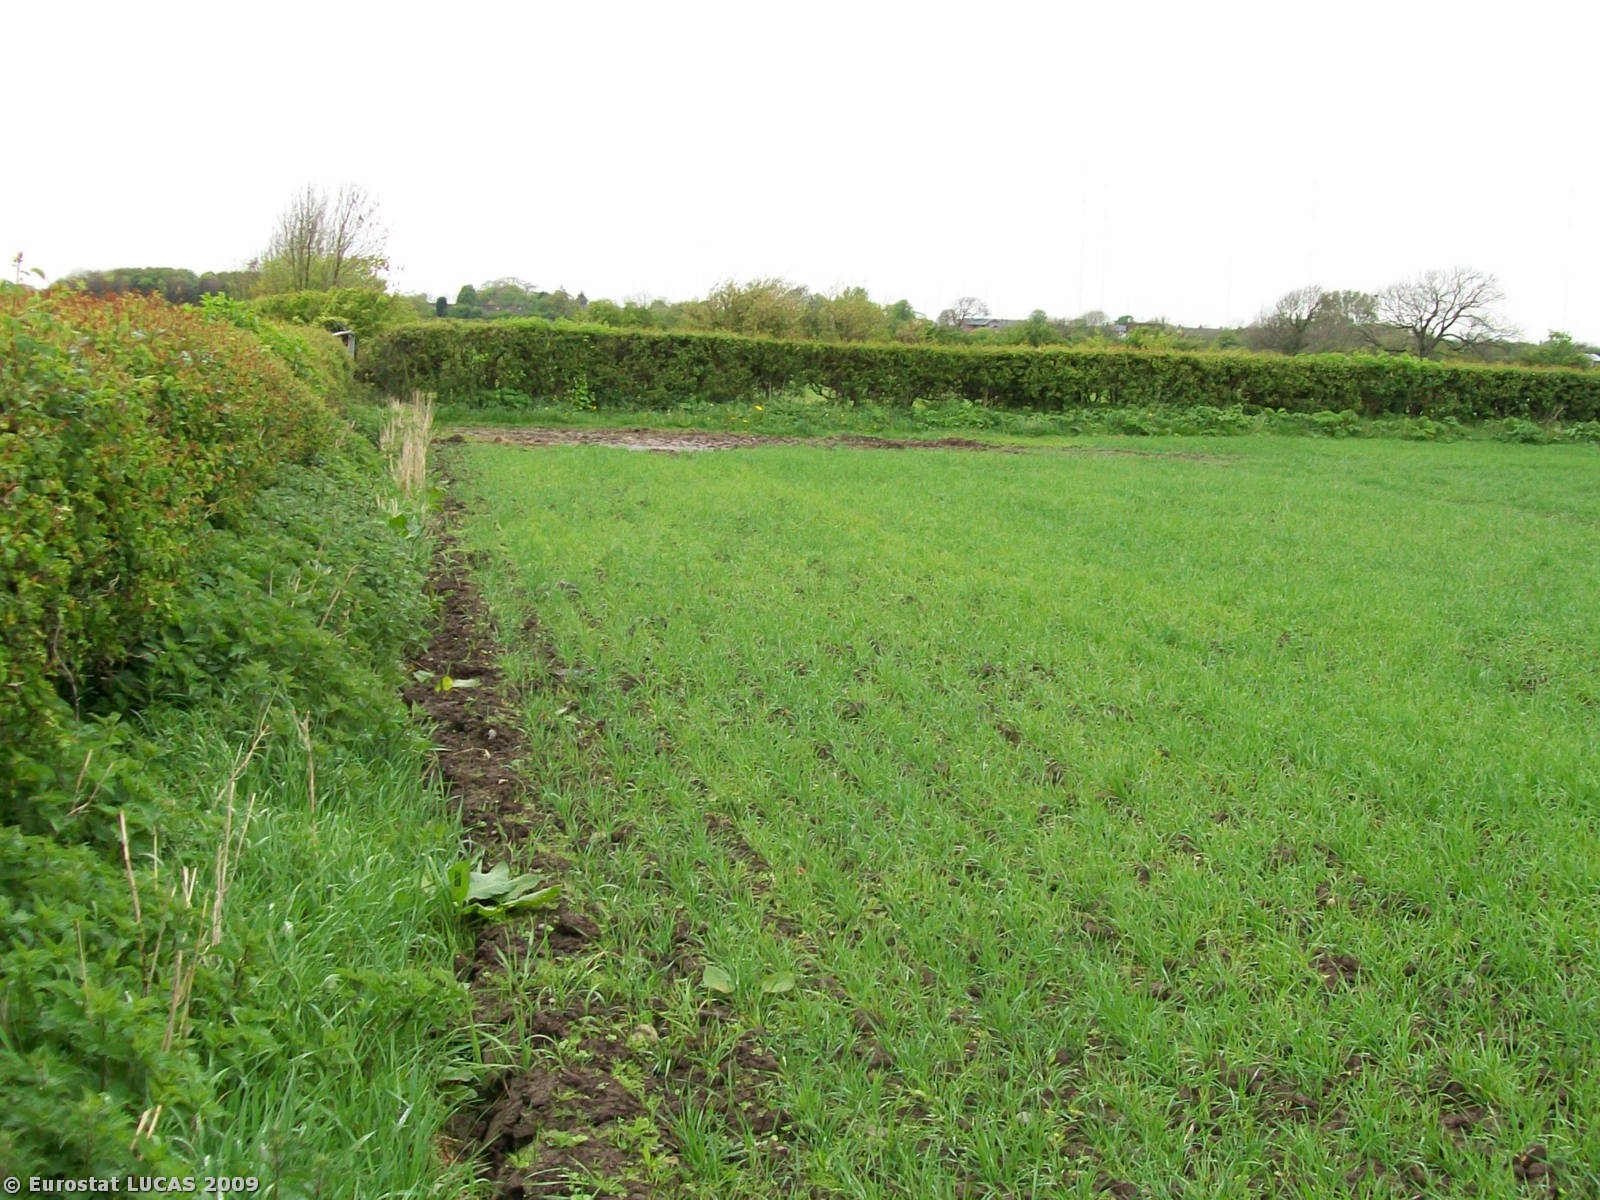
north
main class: Cropland
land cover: Common wheat
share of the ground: 50 - 75 %
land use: Agriculture (excluding fallow land and kitchen gardens)
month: May
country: GB
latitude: 53.8012
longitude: -2.9019
